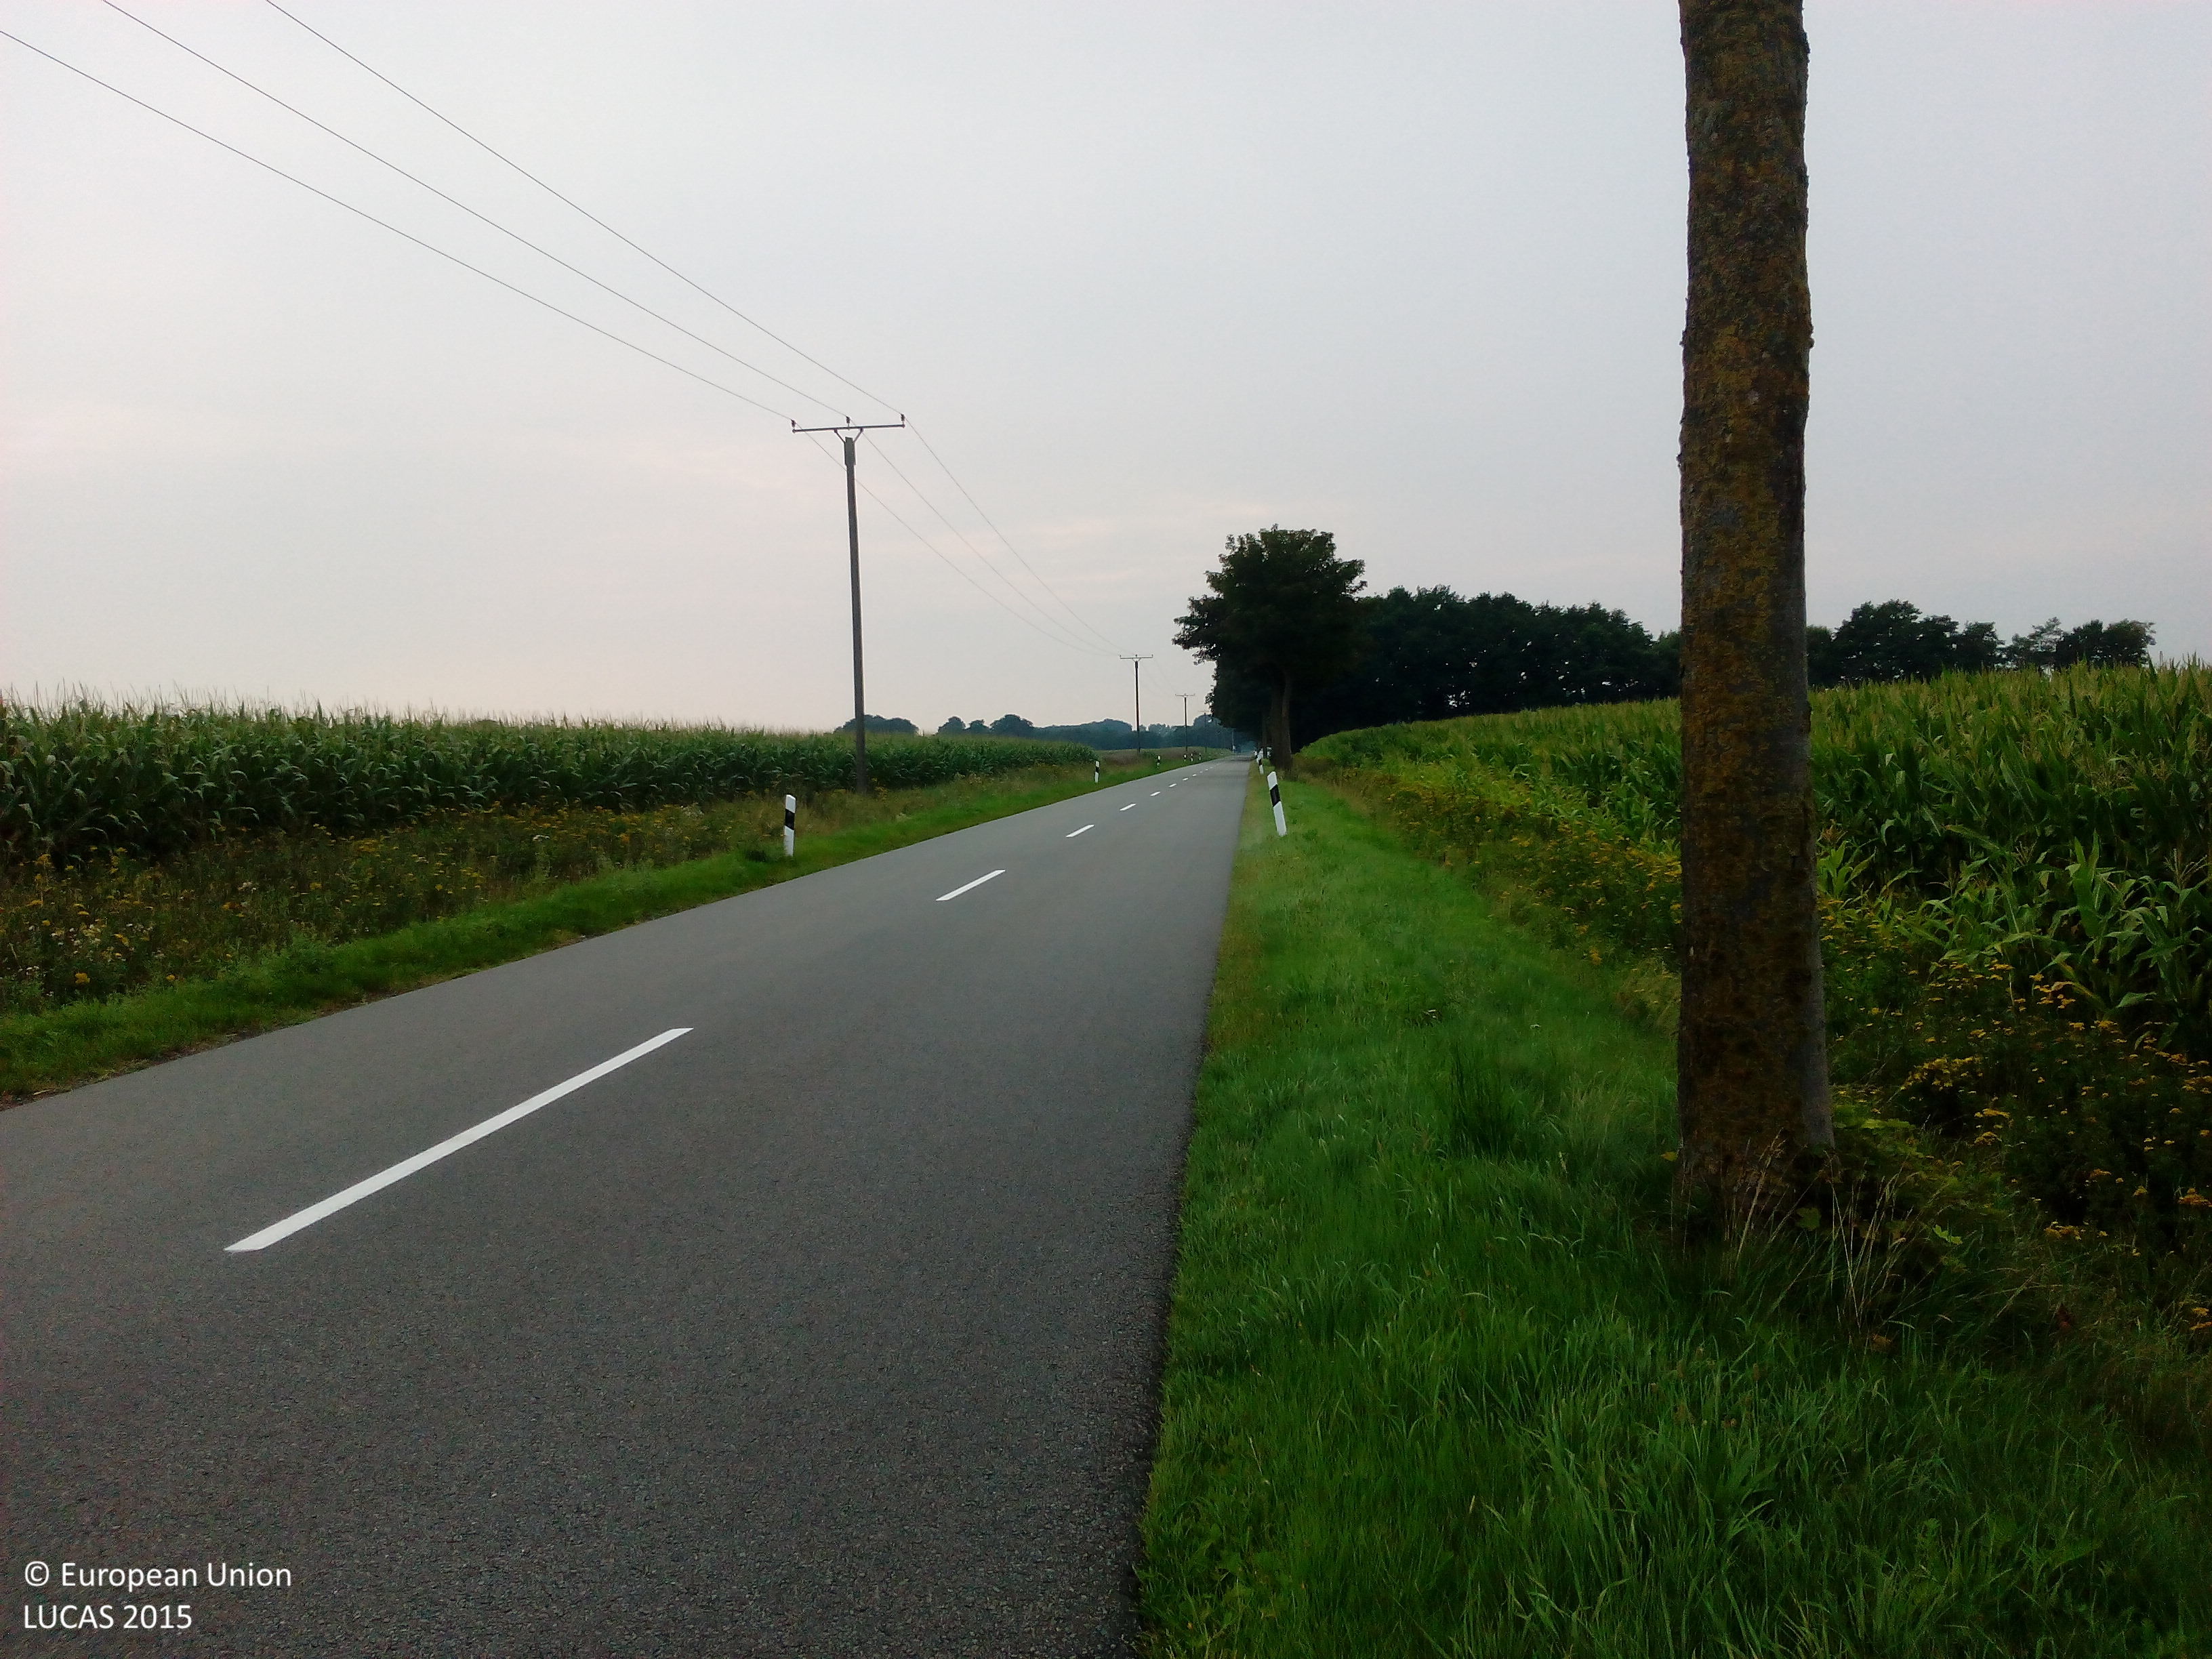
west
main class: Cropland
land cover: Maize
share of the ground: > 75 %
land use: Agriculture (excluding fallow land and kitchen gardens)
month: August
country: DE
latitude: 52.6737
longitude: 8.5068
